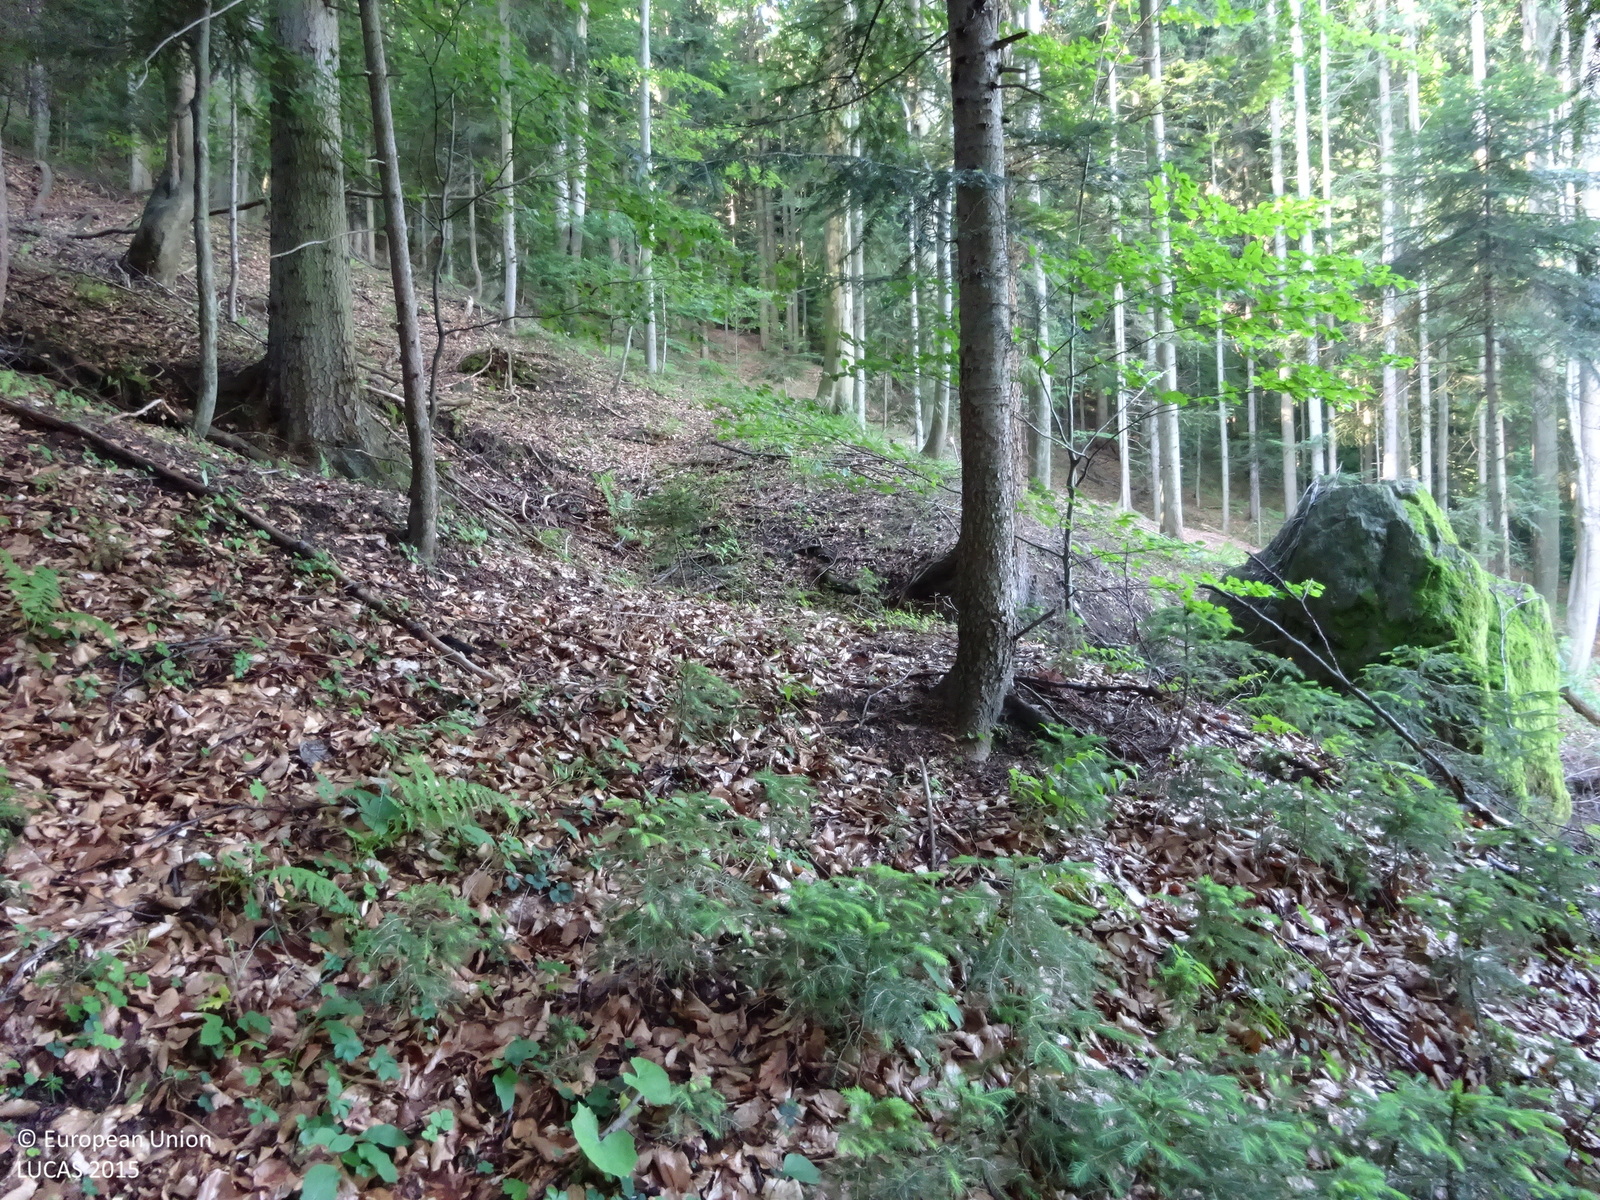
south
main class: Woodland
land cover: Spruce dominated mixed woodland
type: mountainous beech forest
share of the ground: > 75 %
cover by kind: broadleaved forest trees 60 %, coniferous forest trees 30 %, herbaceous plants 5 %, lichens and mosses 5 %
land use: Forestry
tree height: > 5 m
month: June
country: AT
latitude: 46.6534
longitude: 15.2908
